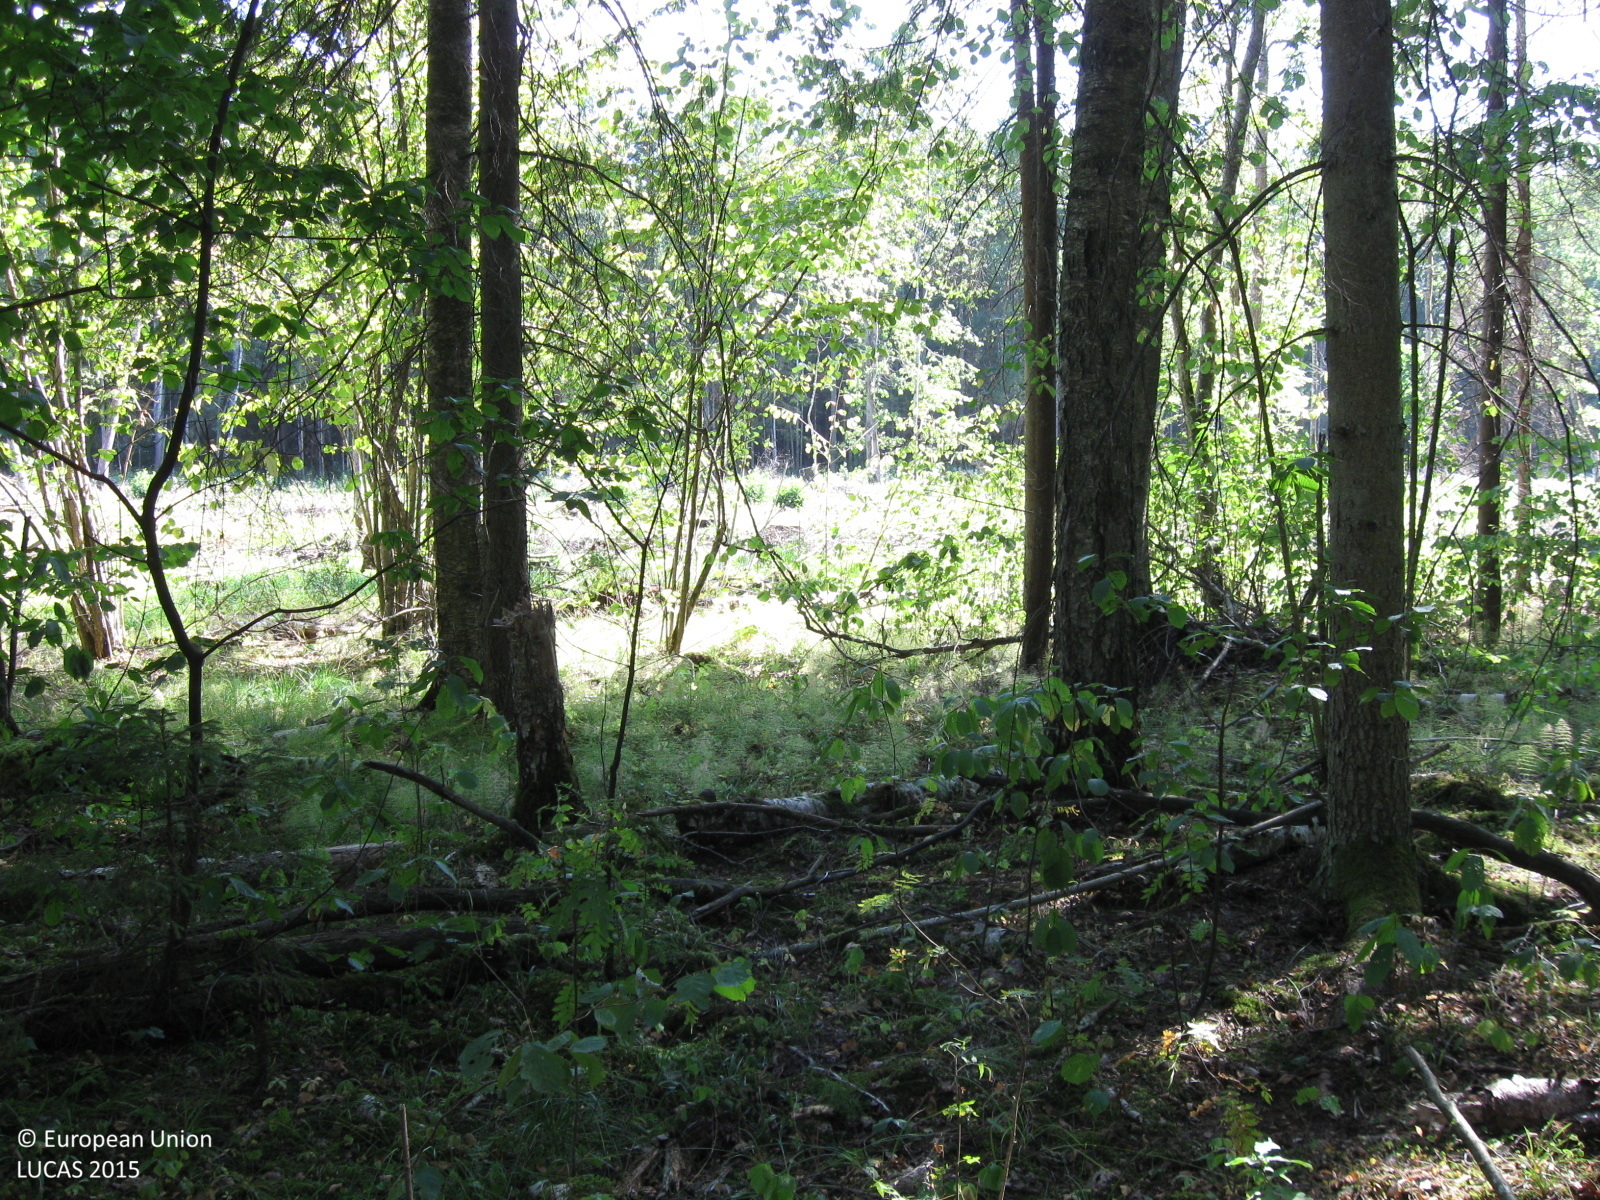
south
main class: Woodland
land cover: Spruce dominated mixed woodland
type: hemiboreal forest and nemoral coniferous forest and mixed broadleaved-coniferous forest
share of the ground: > 75 %
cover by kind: broadleaved forest trees 45 %, coniferous forest trees 40 %, herbaceous plants 10 %, lichens and mosses 5 %
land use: Forestry
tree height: > 5 m
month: August
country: LT
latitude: 55.3096
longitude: 22.5881
